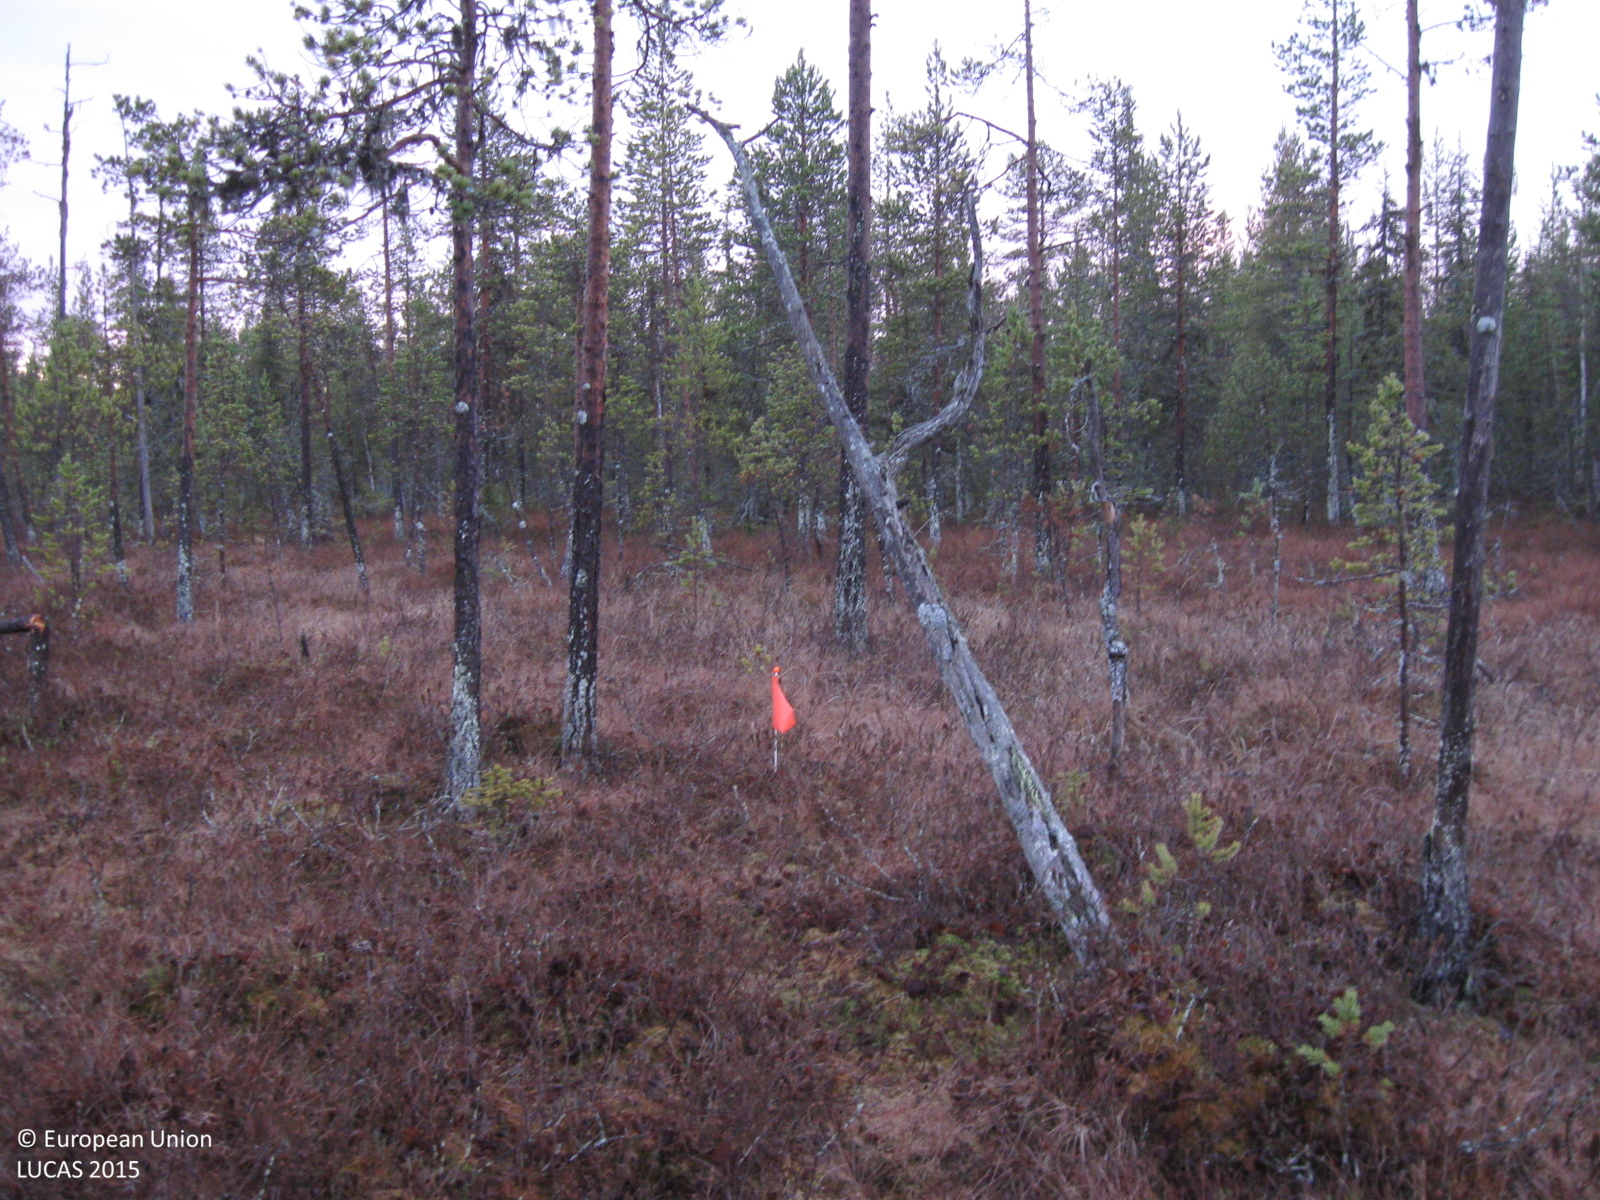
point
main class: Woodland
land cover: Pine dominated coniferous woodland
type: mire and swamp forests
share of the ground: 25 - 50 %
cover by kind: shrubs 40 %, coniferous forest trees 35 %, herbaceous plants 15 %, lichens and mosses 10 %
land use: Semi-natural and natural areas not in use
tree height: < 5 m
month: October
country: SE
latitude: 66.4341
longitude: 20.9201
